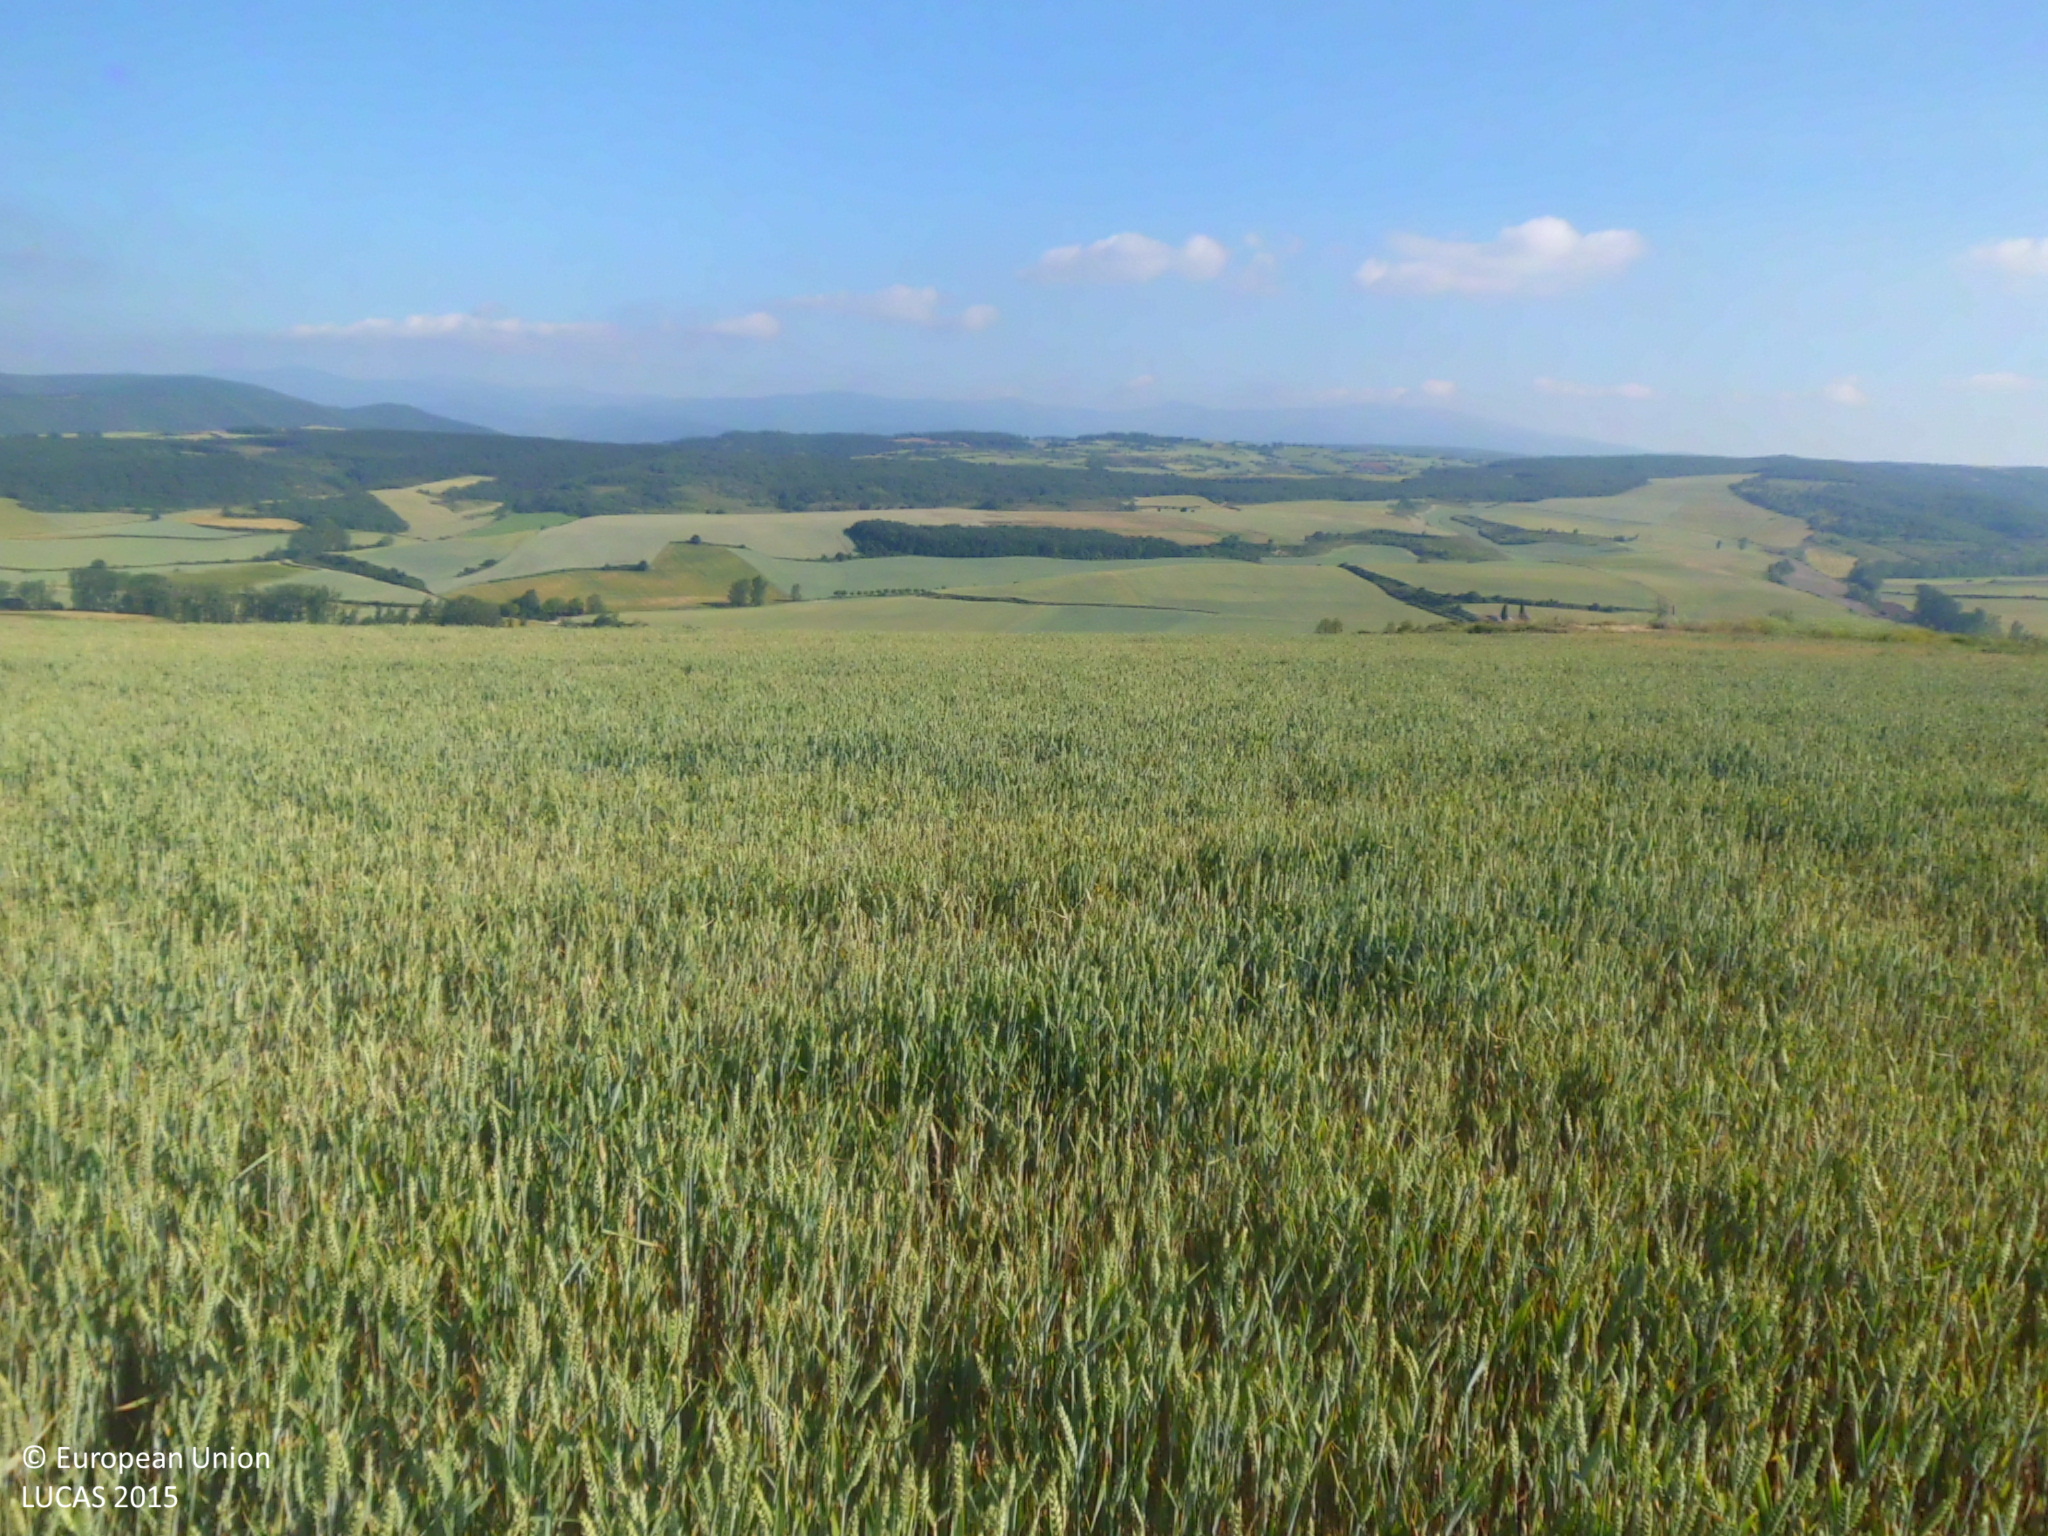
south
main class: Cropland
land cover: Common wheat
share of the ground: > 75 %
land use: Agriculture (excluding fallow land and kitchen gardens)
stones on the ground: < 10 %
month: June
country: ES
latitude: 42.4201
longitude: -3.2407
